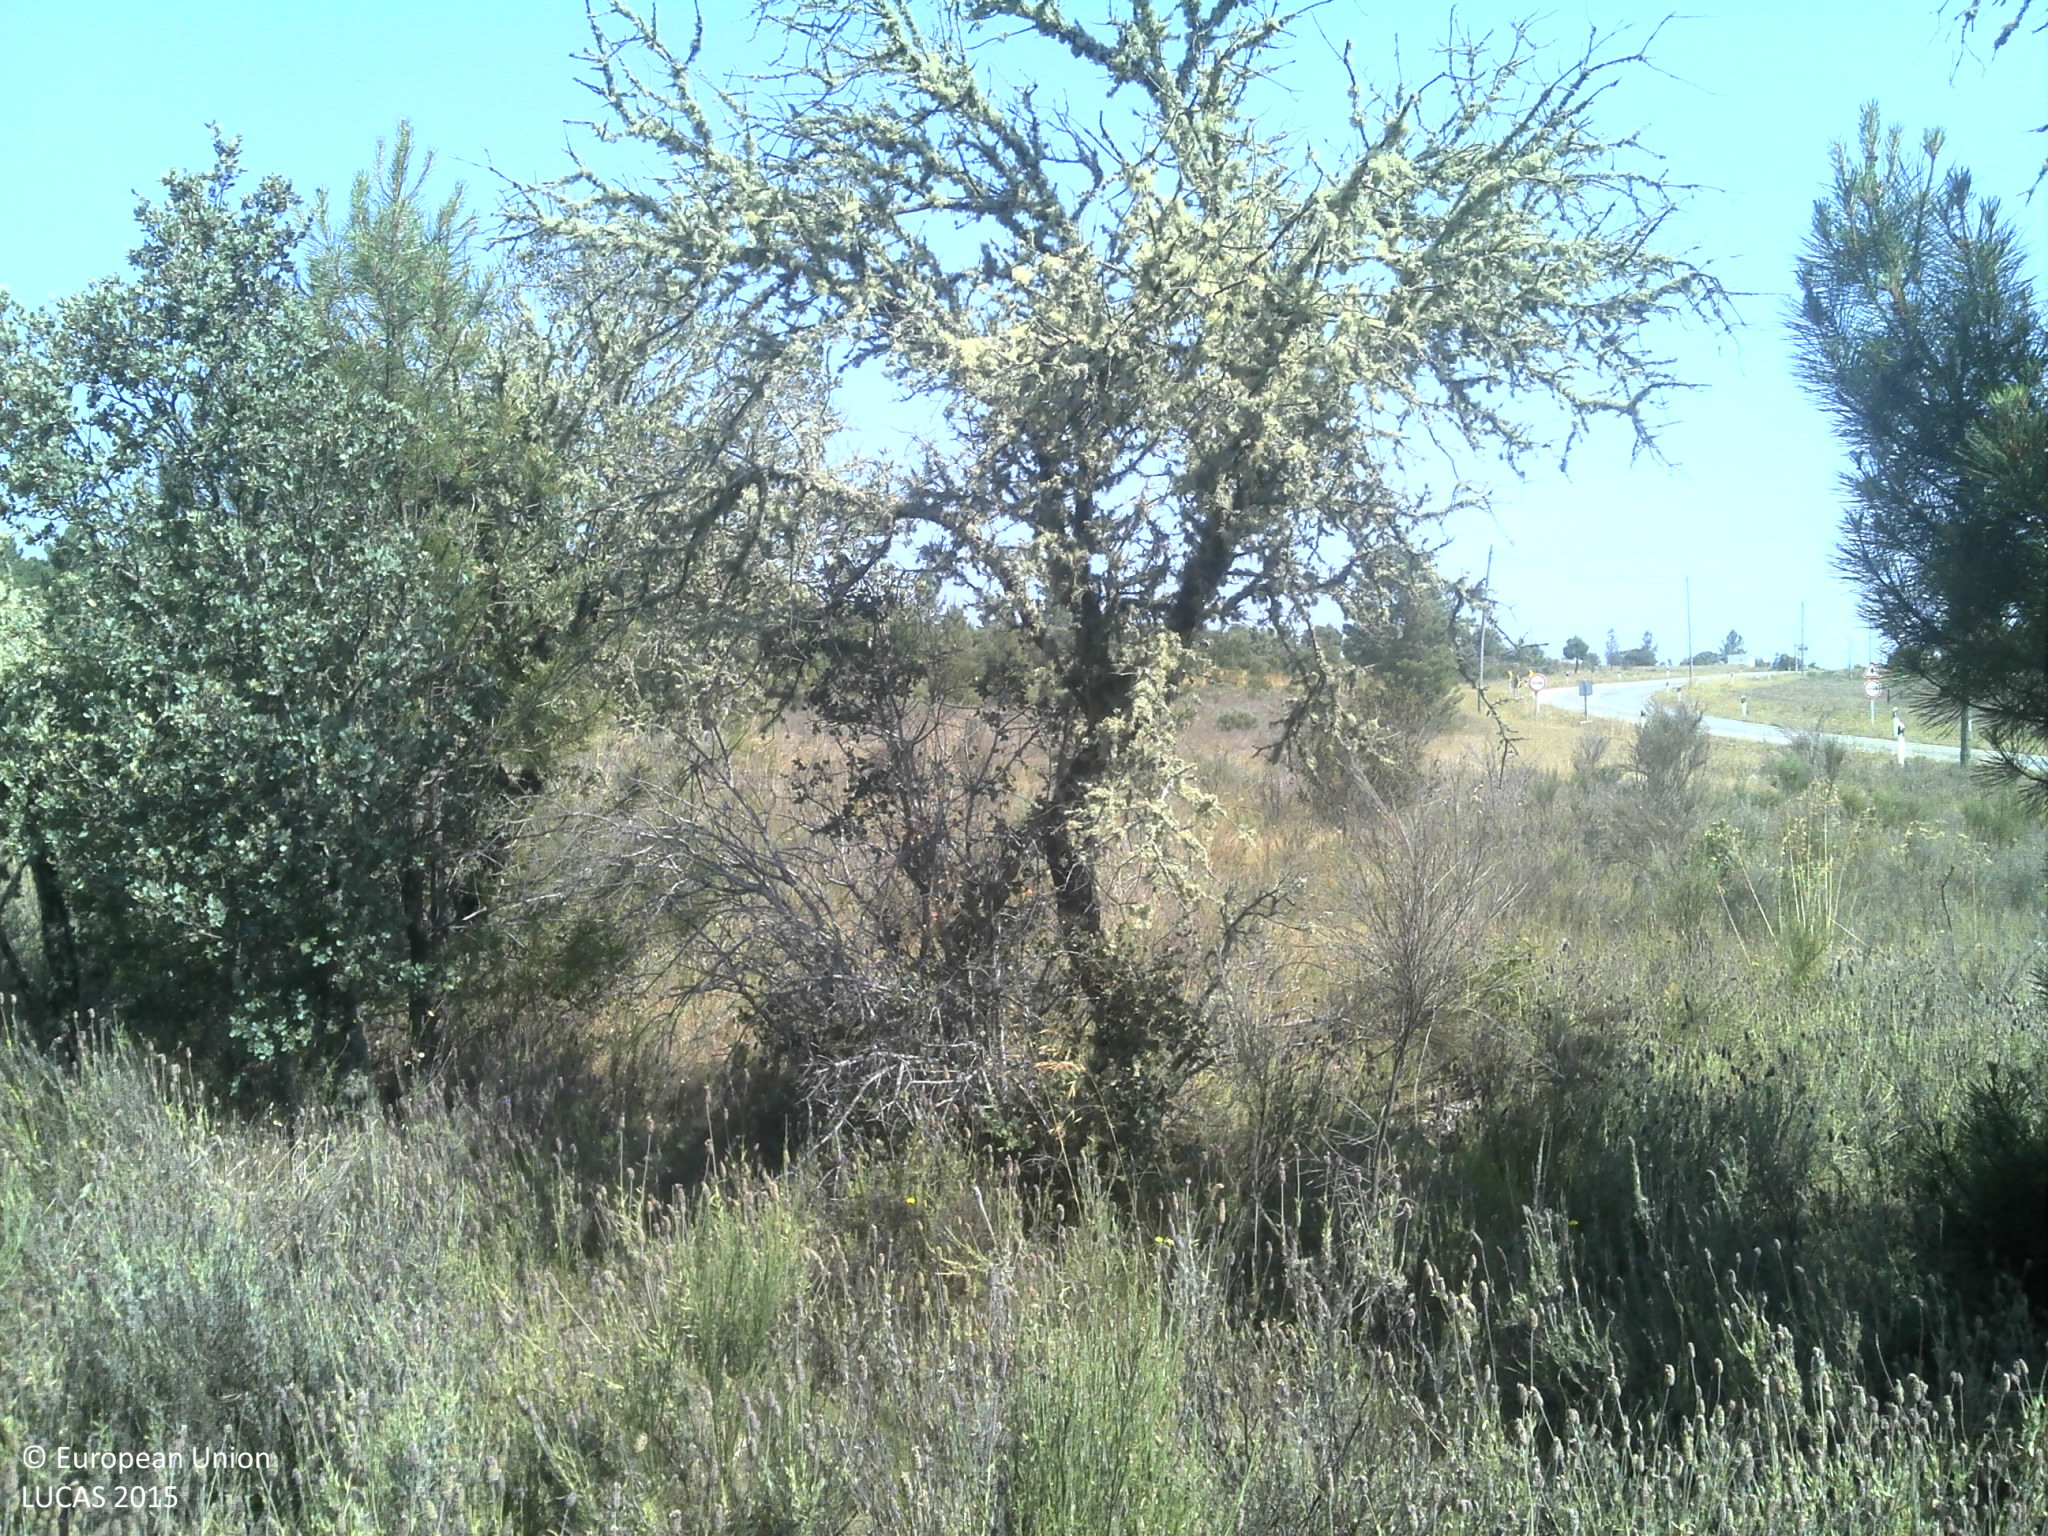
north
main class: Woodland
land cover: Broadleaved woodland
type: broadleaved evergreen forest
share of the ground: 50 - 75 %
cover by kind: broadleaved forest trees 70 %, herbaceous plants 15 %, shrubs 10 %, unconsolidated bare surface 5 %
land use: Forestry
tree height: > 5 m
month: June
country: PT
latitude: 40.4526
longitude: -6.8744
